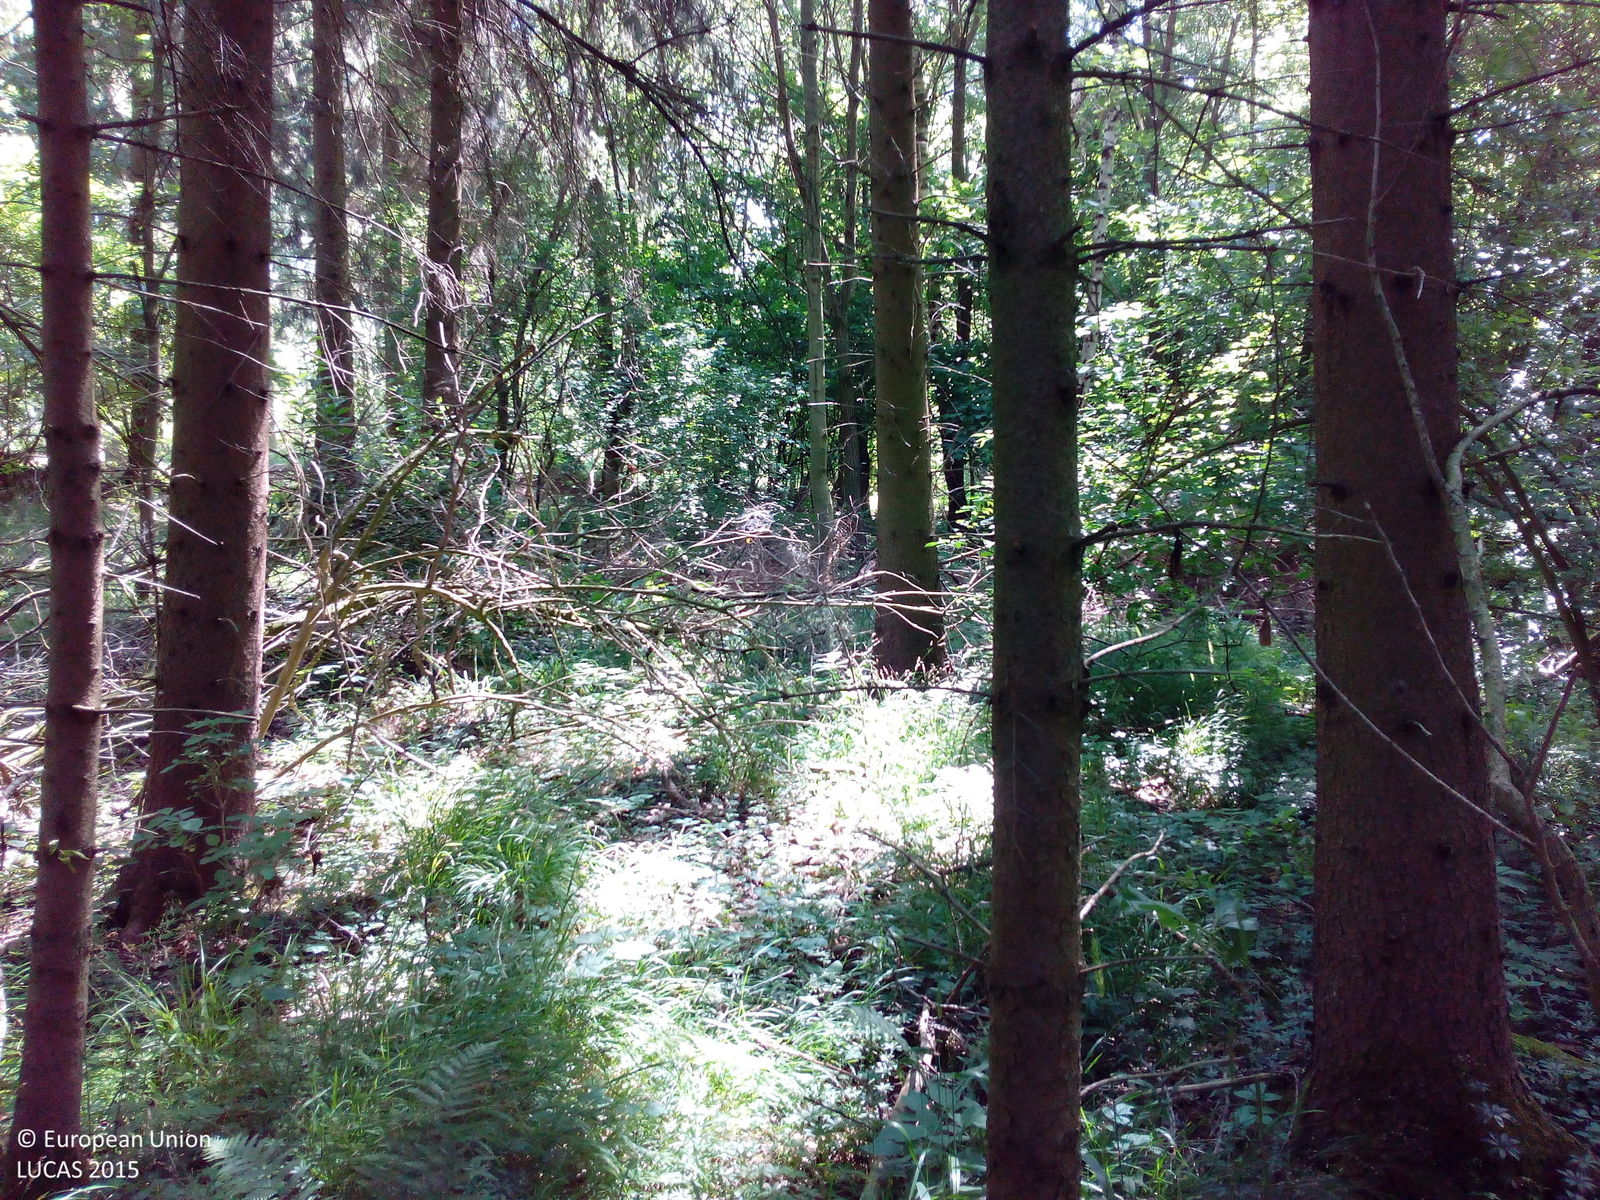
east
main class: Woodland
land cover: Spruce dominated mixed woodland
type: hemiboreal forest and nemoral coniferous forest and mixed broadleaved-coniferous forest
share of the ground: > 75 %
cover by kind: broadleaved forest trees 65 %, coniferous forest trees 25 %, herbaceous plants 10 %
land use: Community services
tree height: > 5 m
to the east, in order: Spruce dominated mixed woodland; Tracks; Spruce dominated mixed woodland
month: June
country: DE
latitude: 51.8381
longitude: 9.8694
